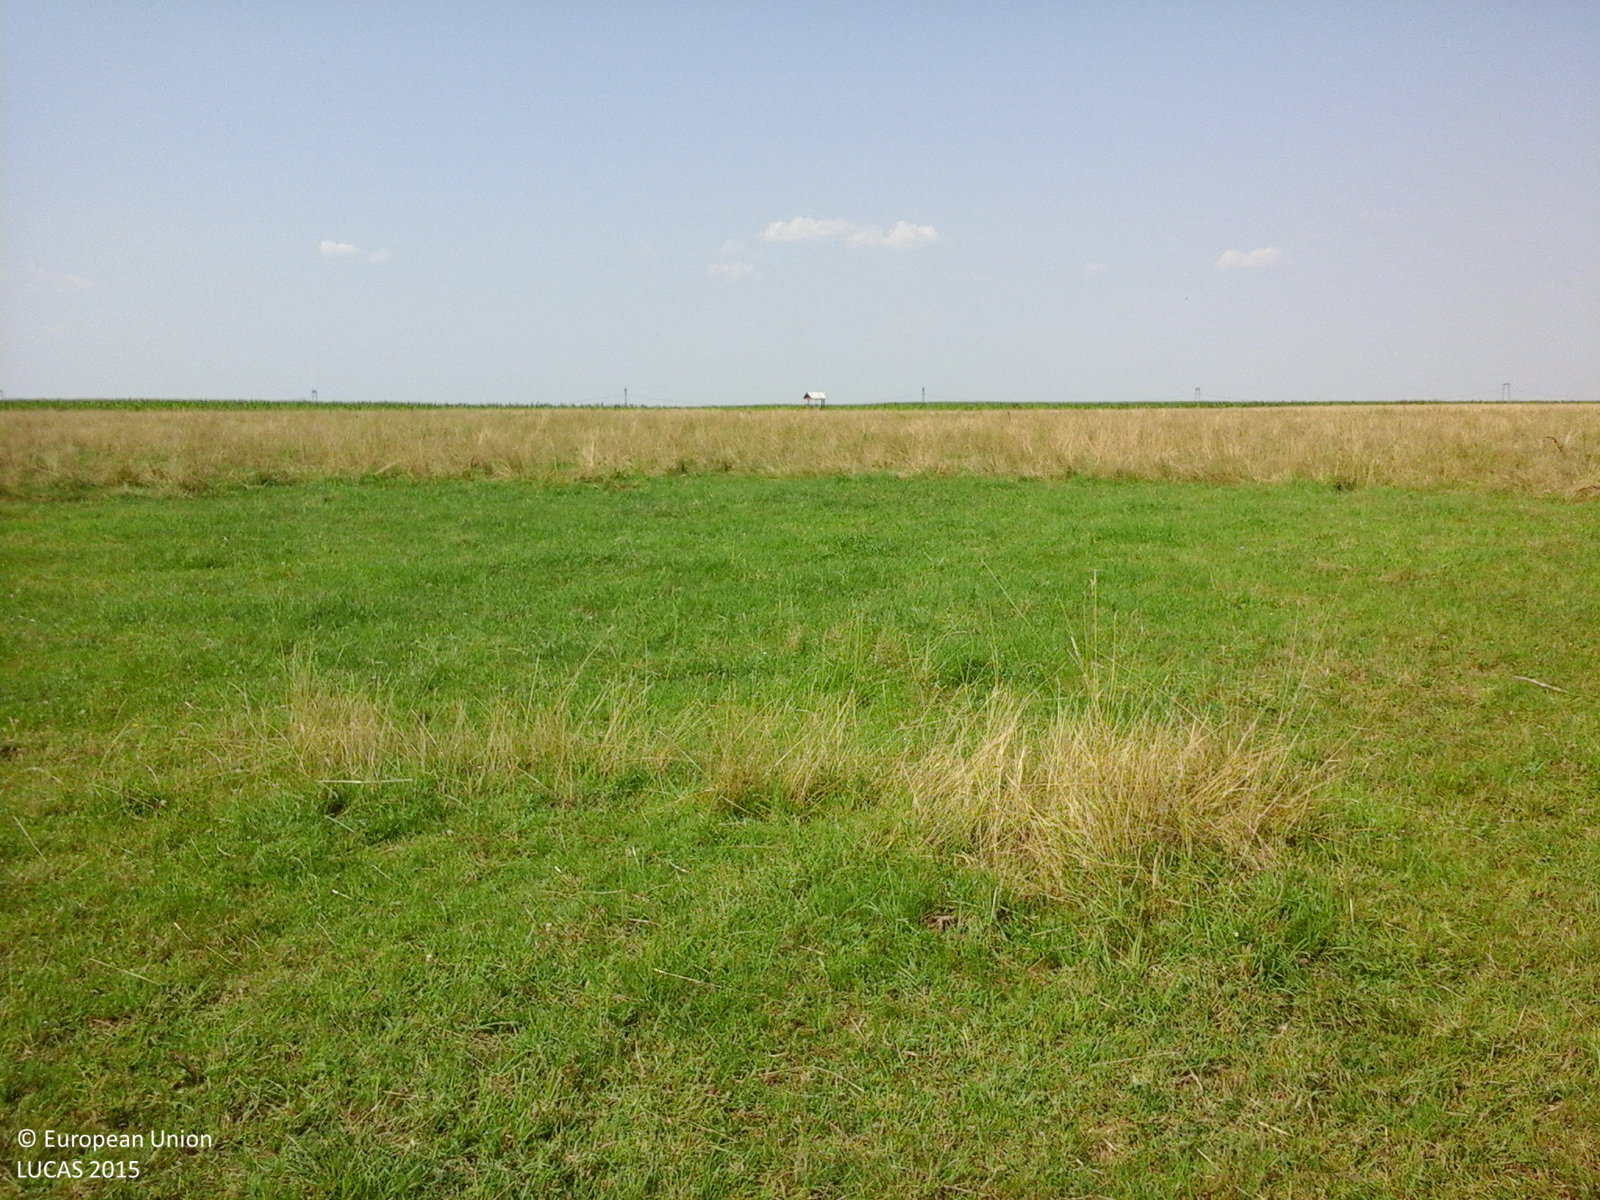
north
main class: Grassland
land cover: Grassland without tree/shrub cover
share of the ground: > 75 %
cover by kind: herbaceous plants 100 %
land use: Agriculture (excluding fallow land and kitchen gardens)
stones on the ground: < 10 %
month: July
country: RO
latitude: 44.5961
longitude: 24.9590
